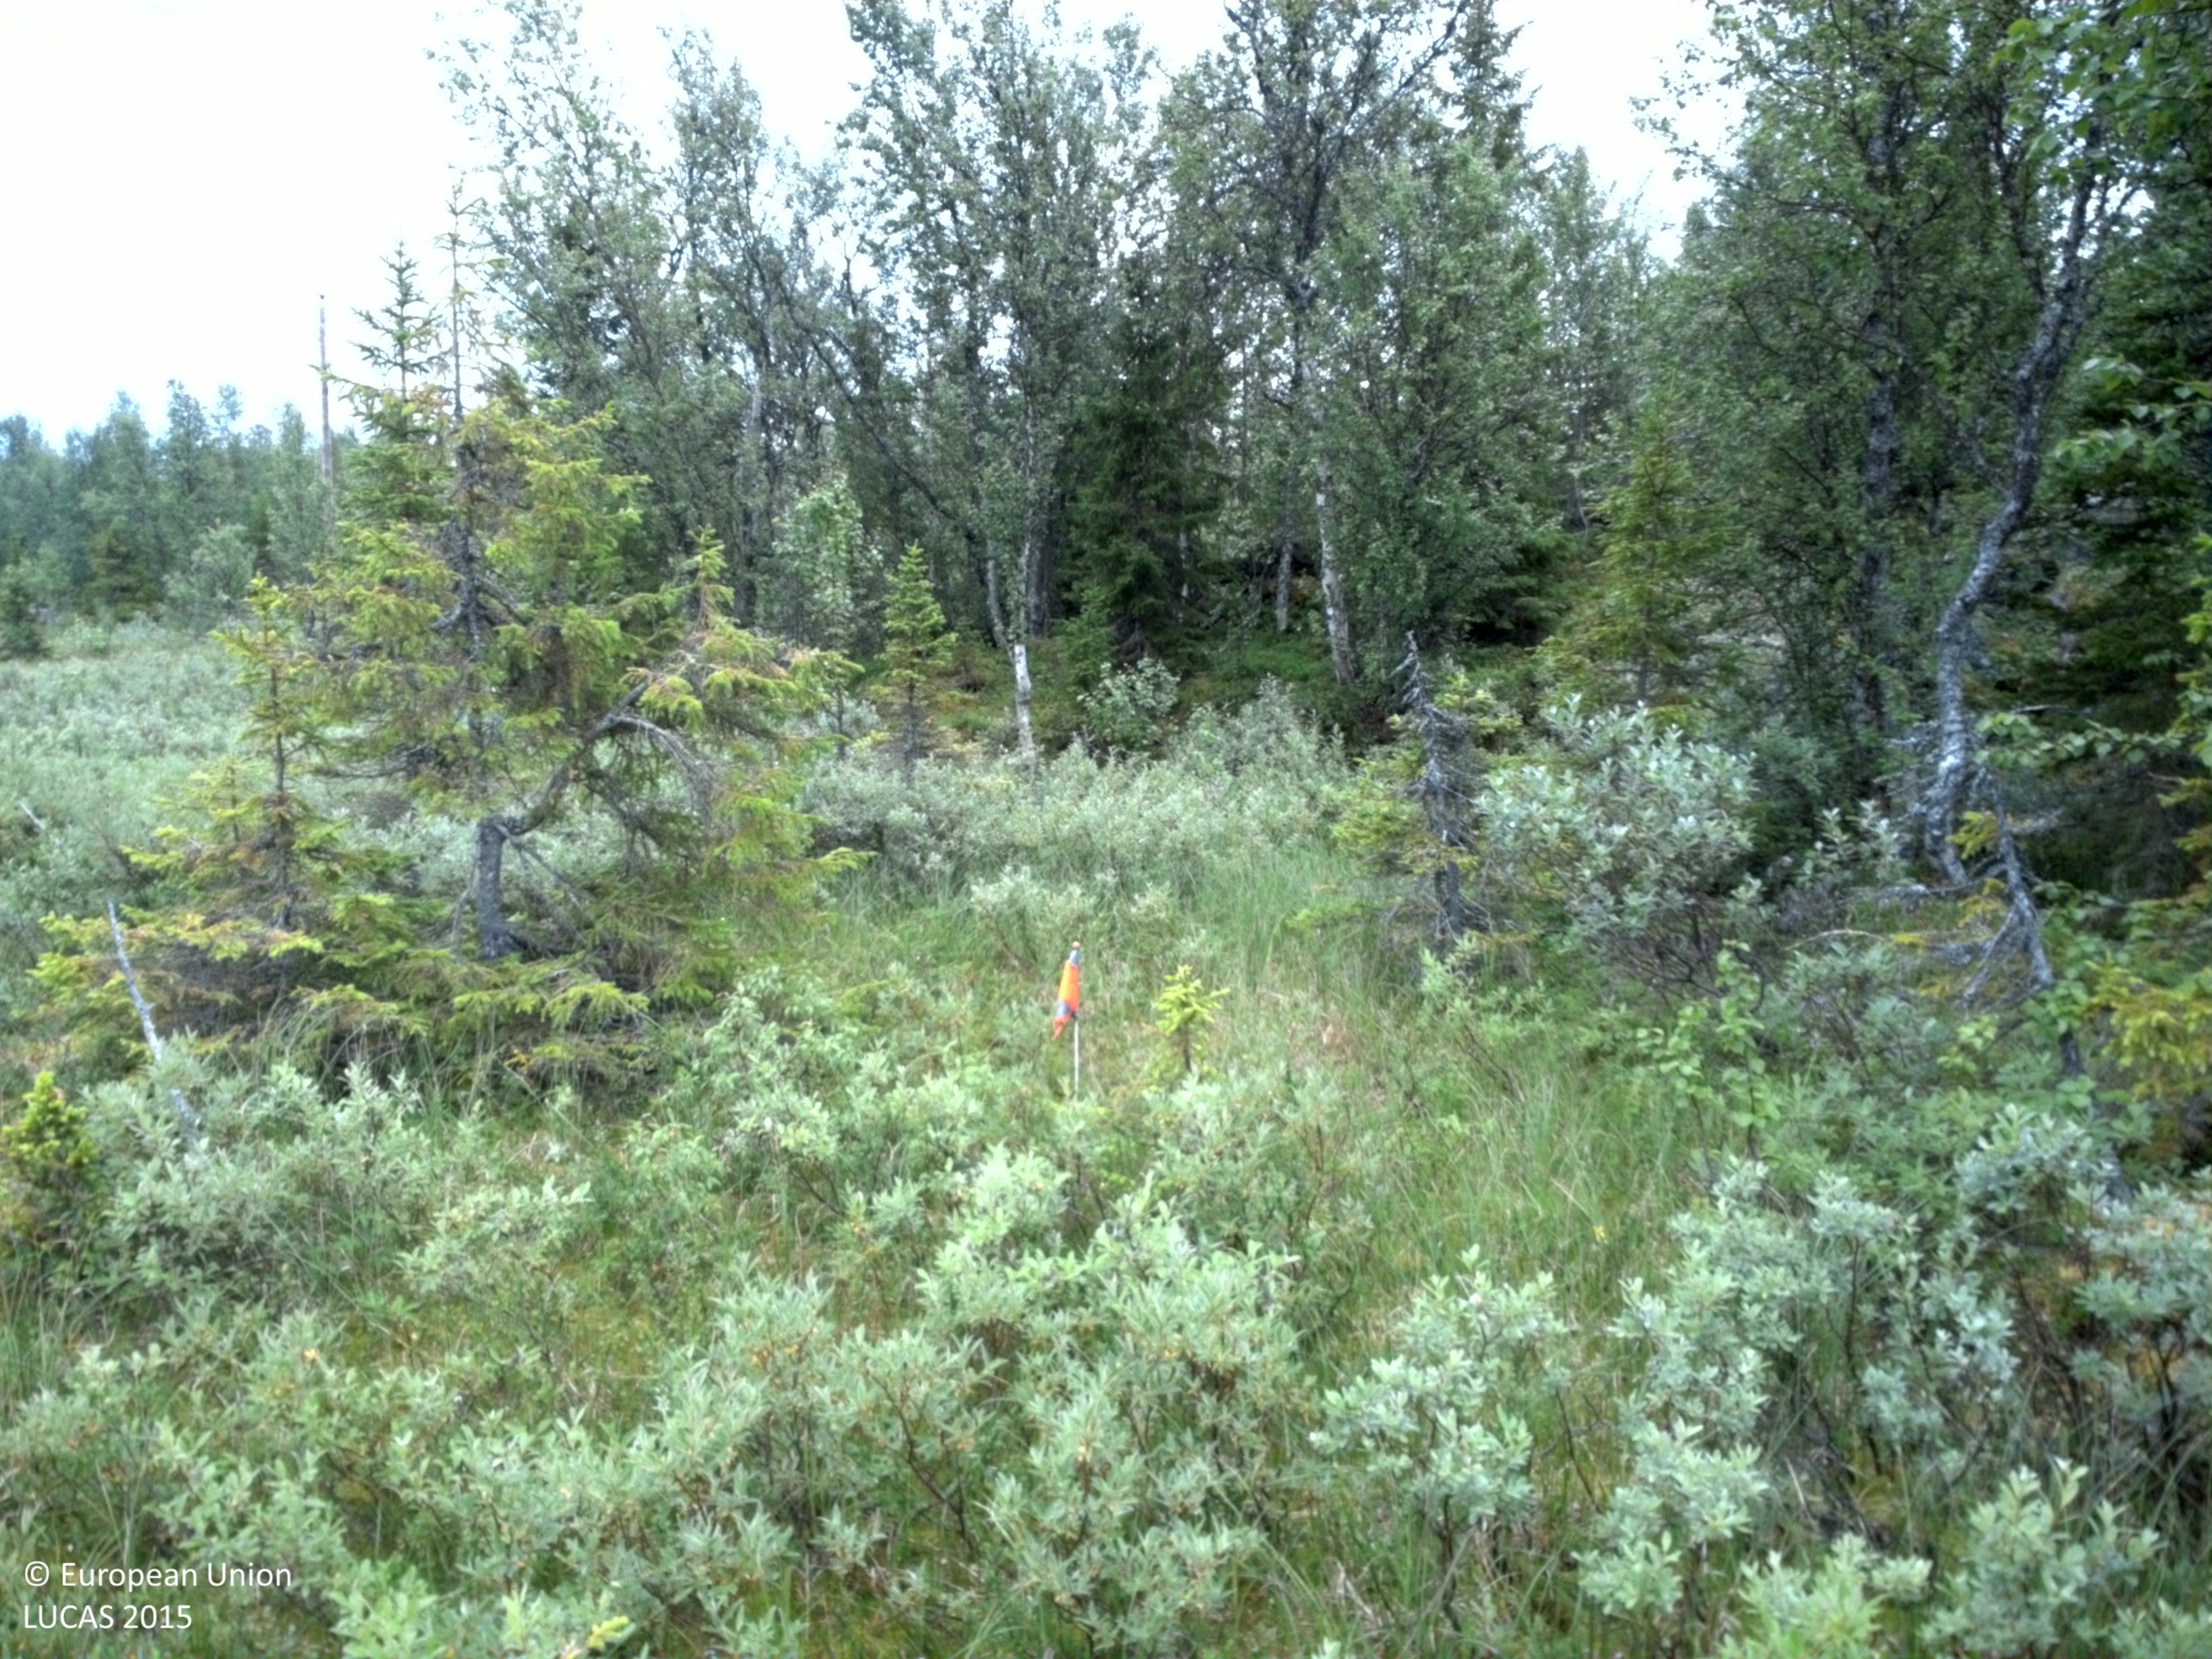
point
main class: Shrubland
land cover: Shrubland with sparse tree cover
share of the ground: > 75 %
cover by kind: shrubs 75 %, herbaceous plants 10 %, lichens and mosses 10 %, coniferous forest trees 5 %
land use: Semi-natural and natural areas not in use
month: August
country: SE
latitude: 64.9909
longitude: 15.5005
